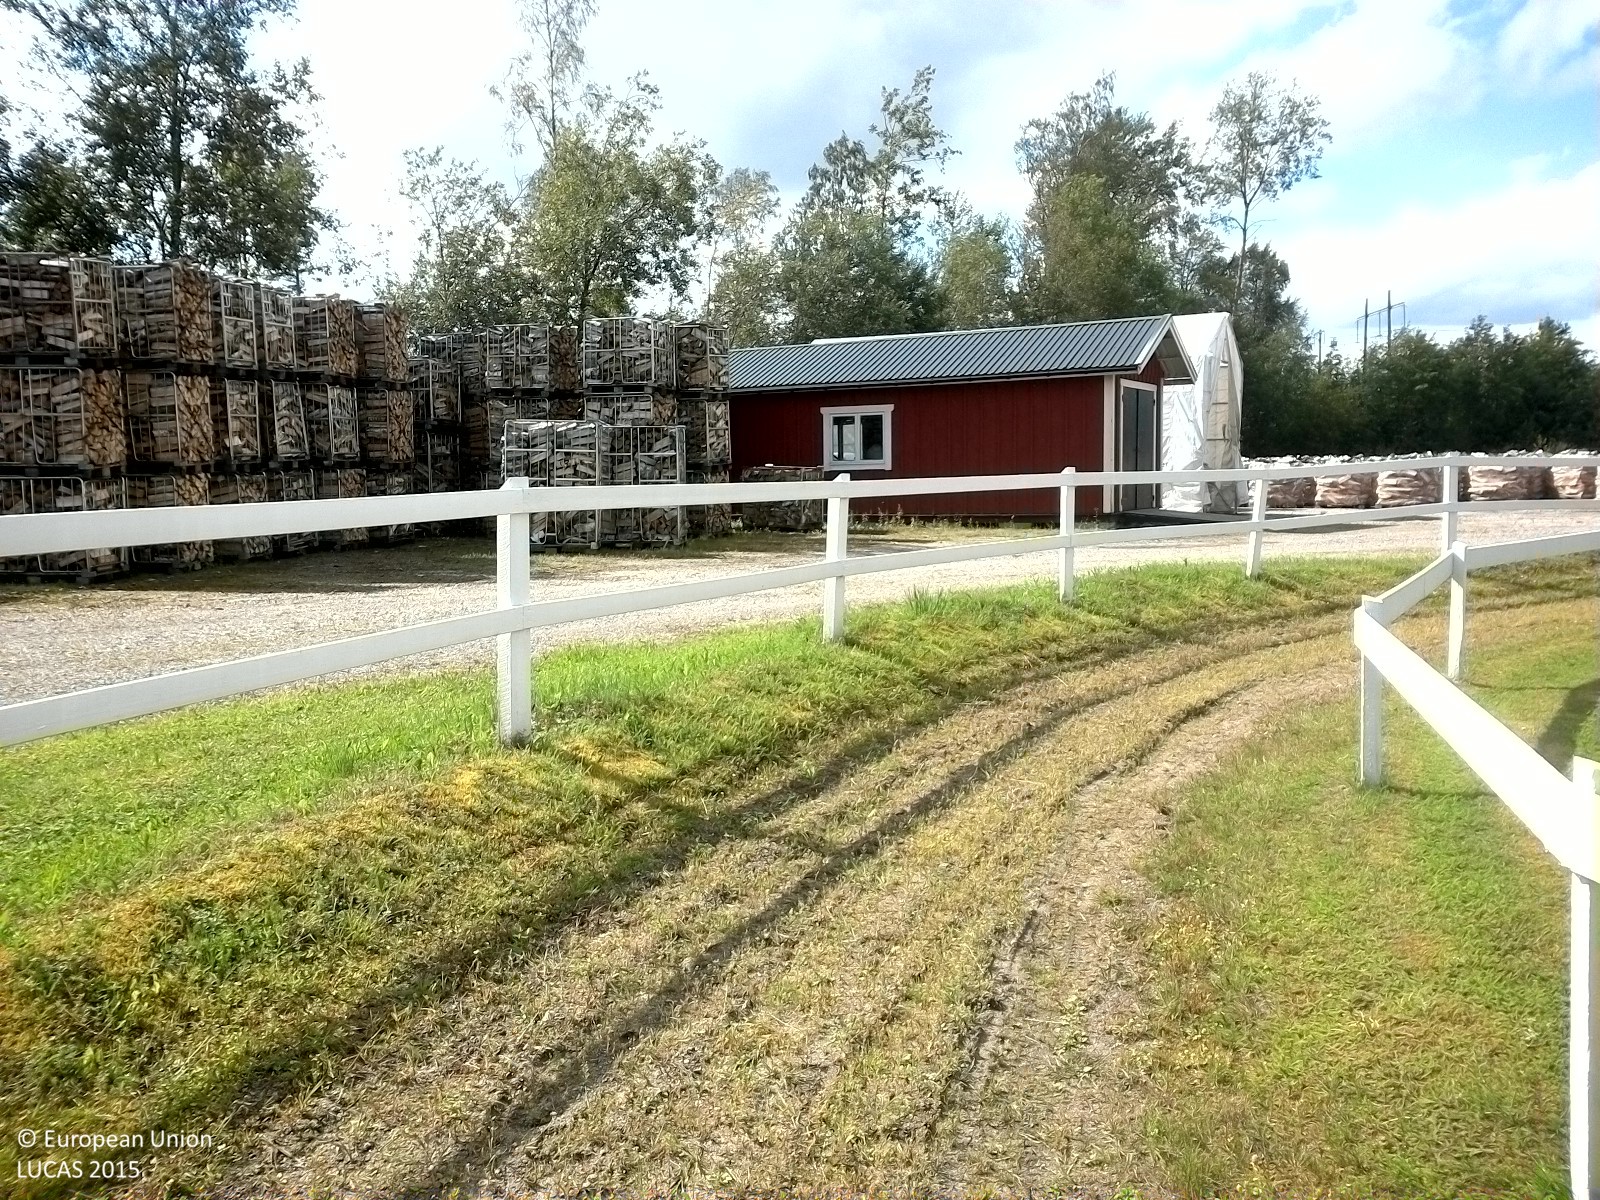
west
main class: Grassland
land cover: Grassland without tree/shrub cover
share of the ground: > 75 %
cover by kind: herbaceous plants 90 %, consolidated bare surface 10 %
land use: Sport
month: August
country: SE
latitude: 59.2064
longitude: 15.0528
